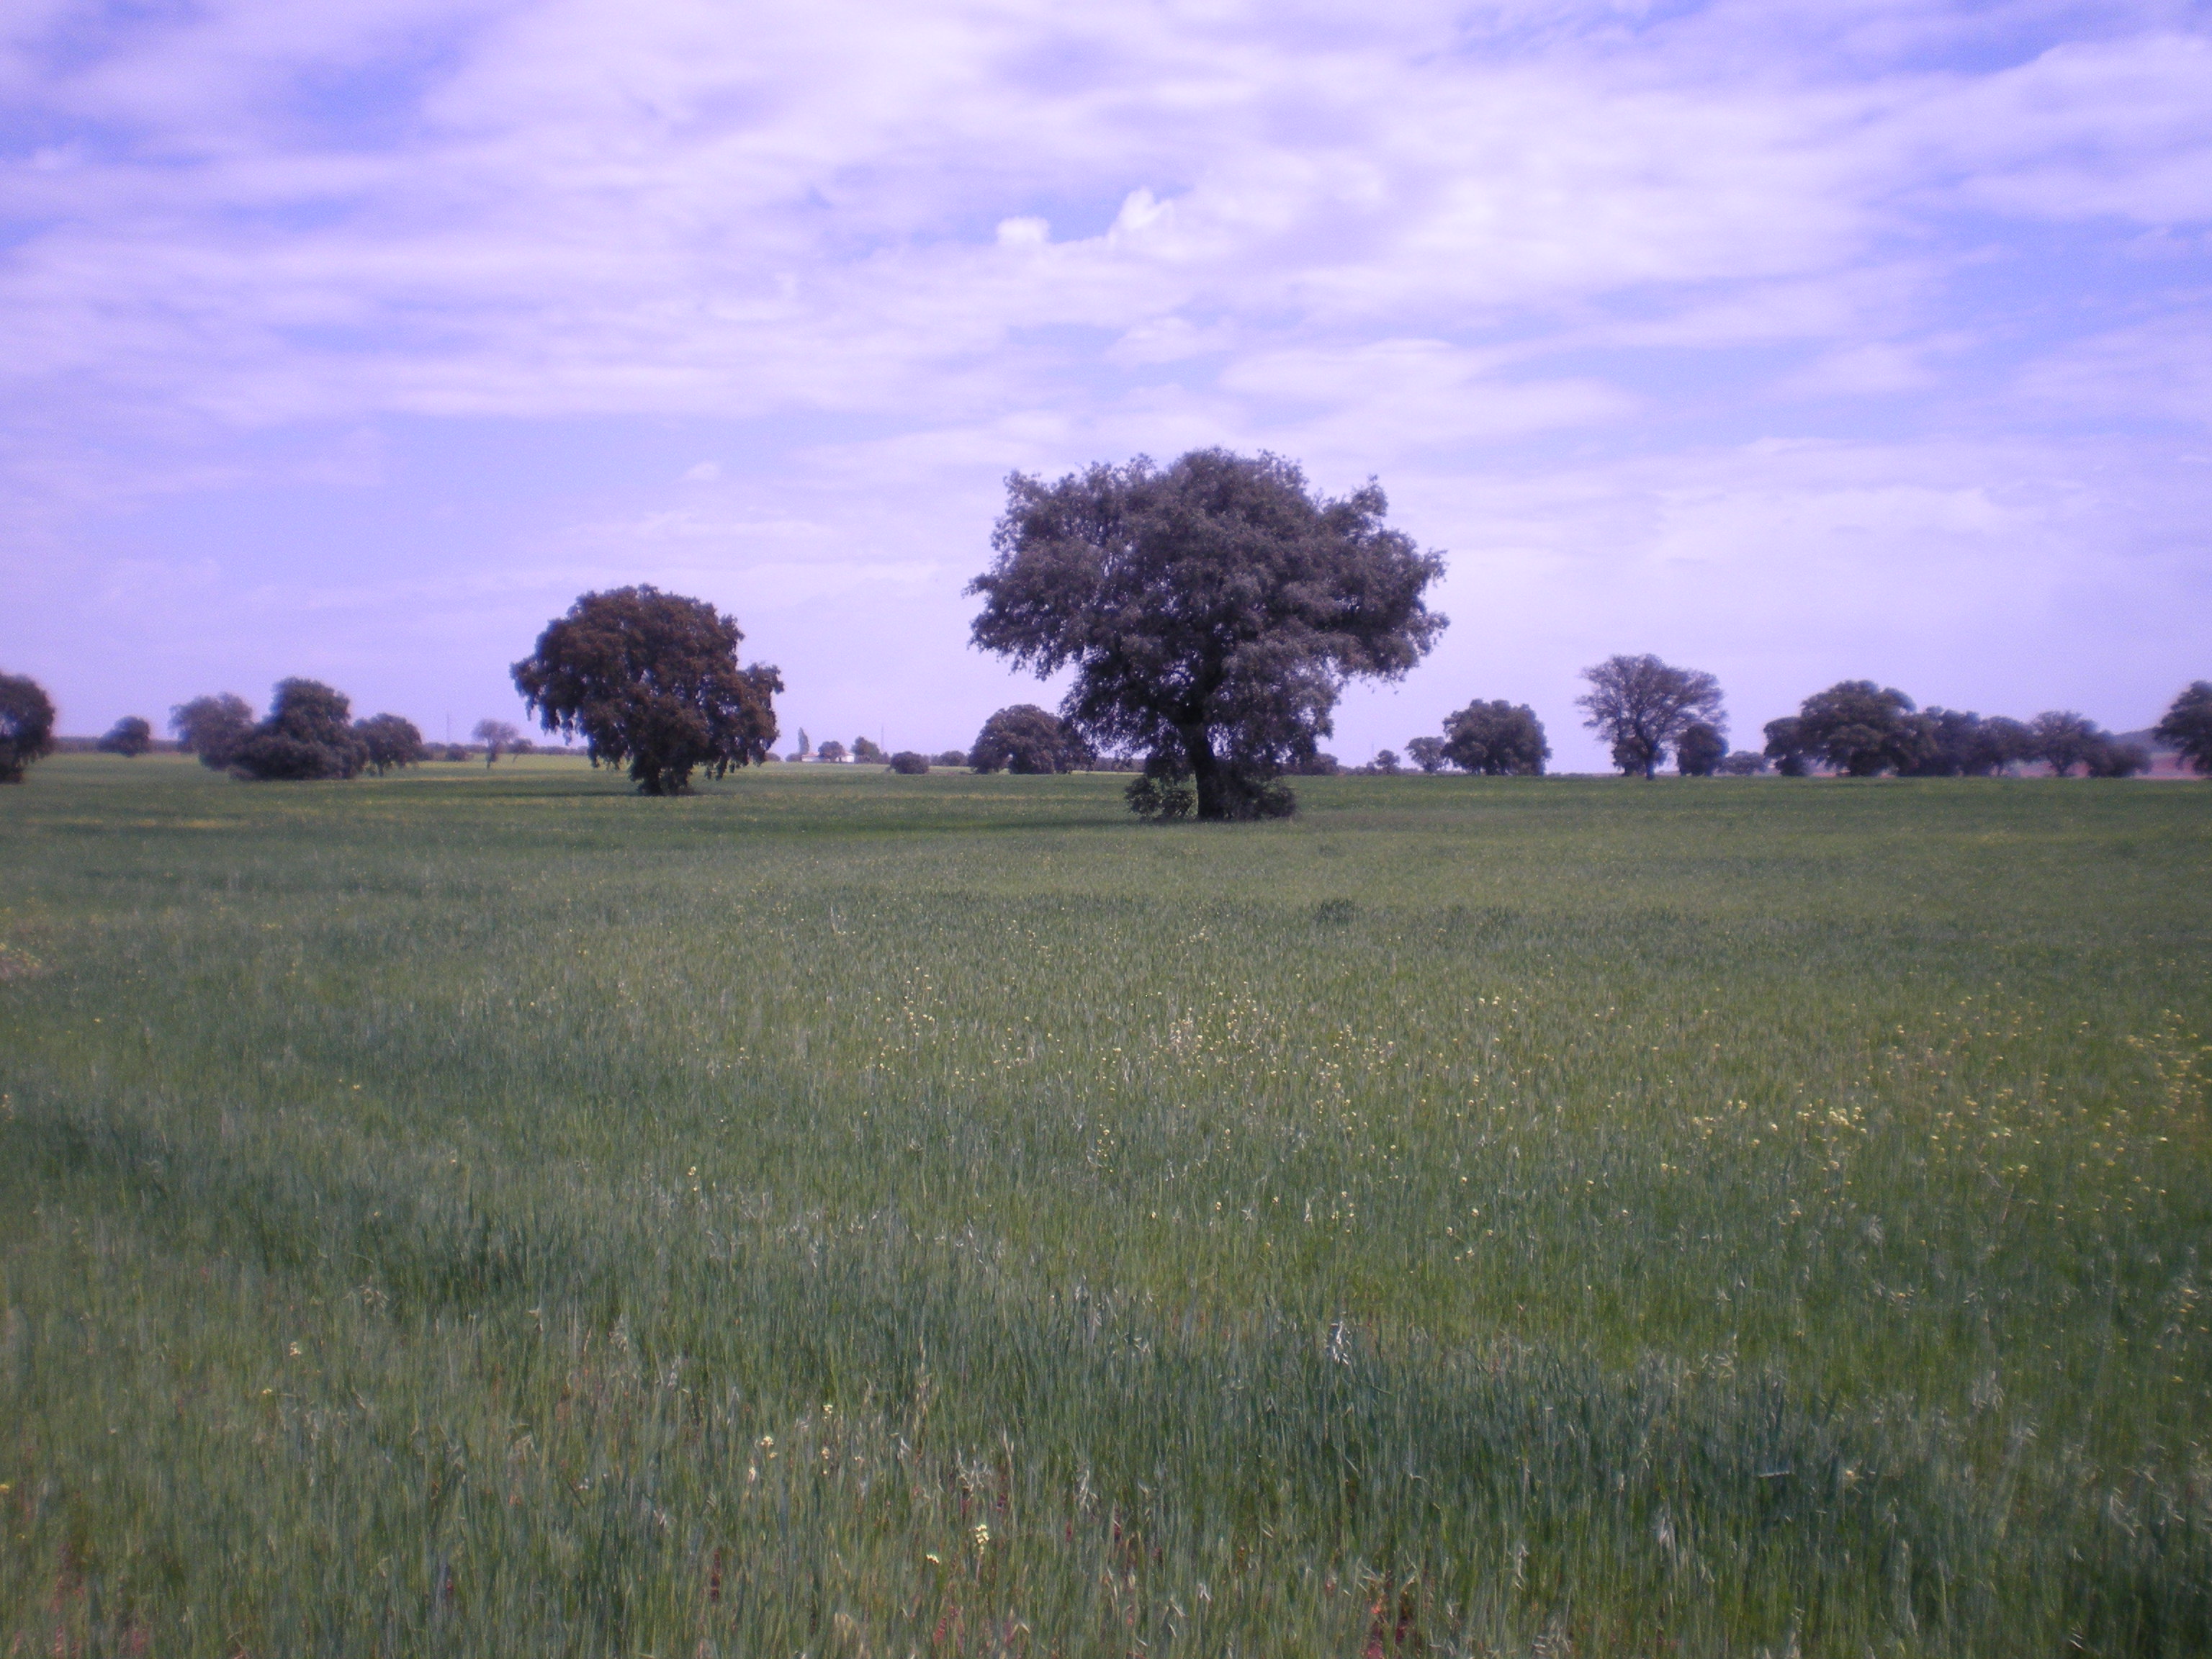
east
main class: Cropland
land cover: Oats
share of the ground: > 75 %
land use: Agriculture (excluding fallow land and kitchen gardens)
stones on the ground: 10 - 25 %
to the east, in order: Oats; Common wheat; Single bushes/trees; Common wheat
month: April
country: ES
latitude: 38.5964
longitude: -3.5009
